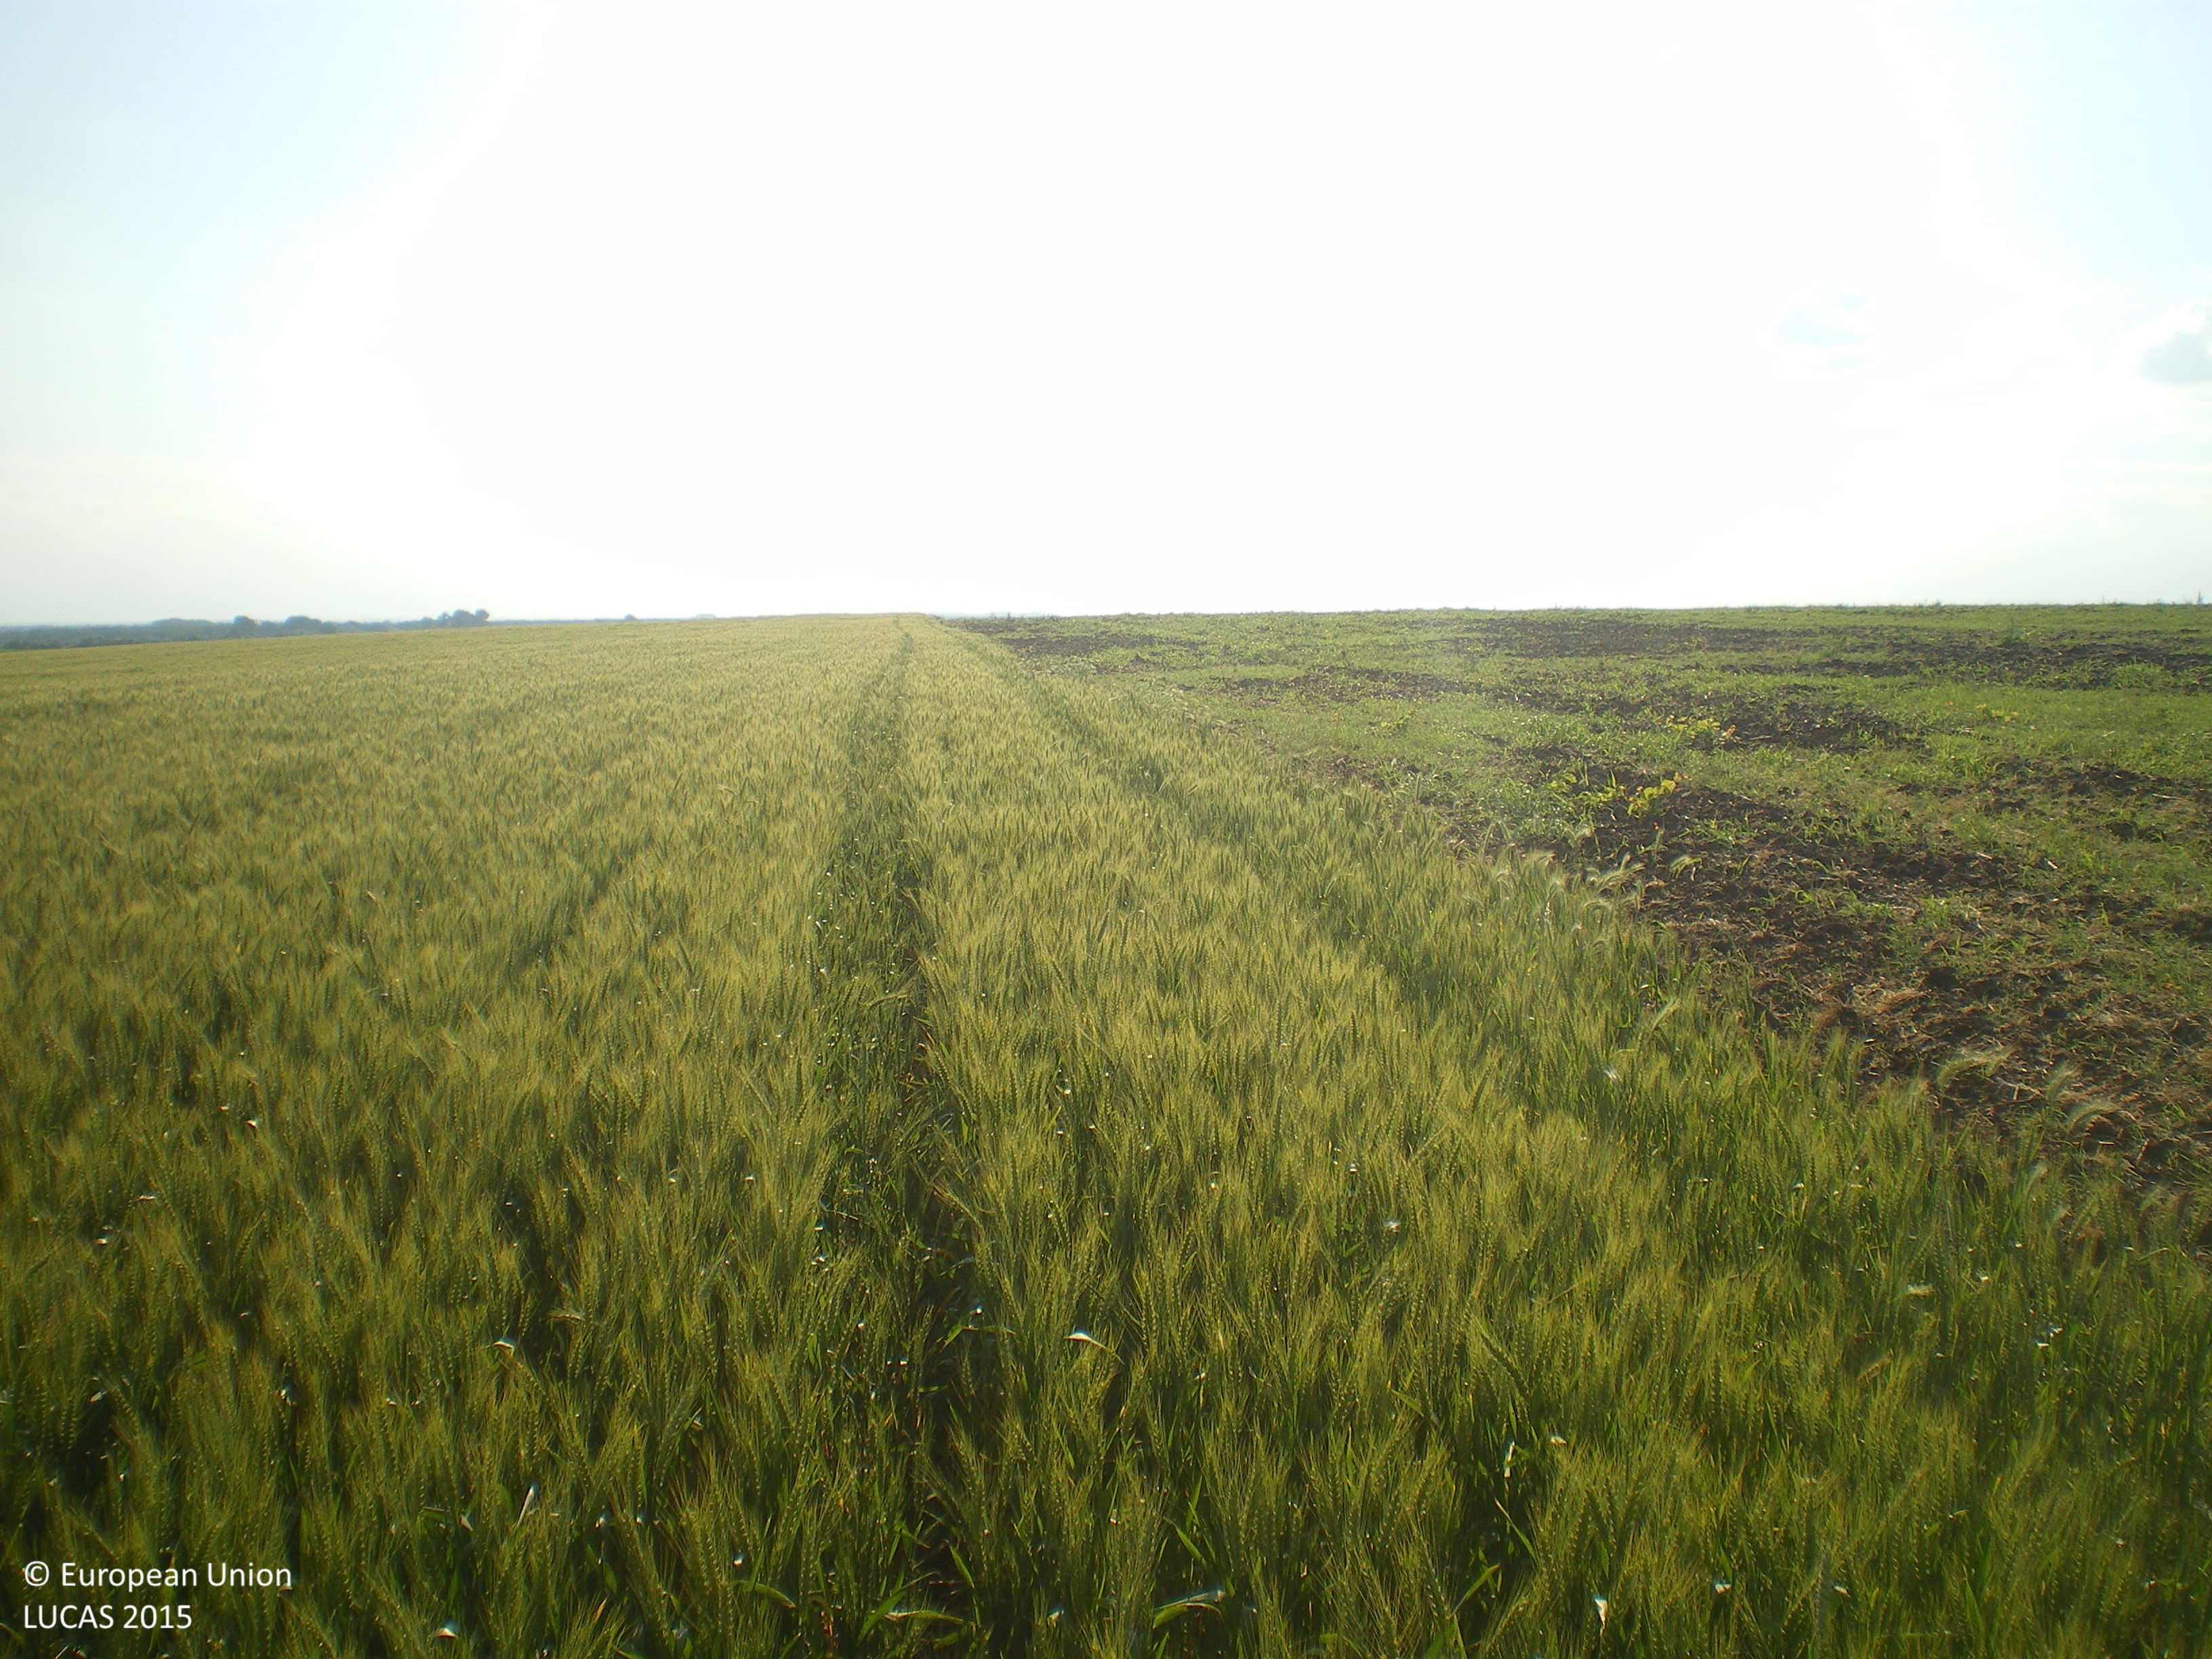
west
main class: Cropland
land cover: Durum wheat
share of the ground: > 75 %
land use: Agriculture (excluding fallow land and kitchen gardens)
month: May
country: BG
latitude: 42.2300
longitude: 25.2190
